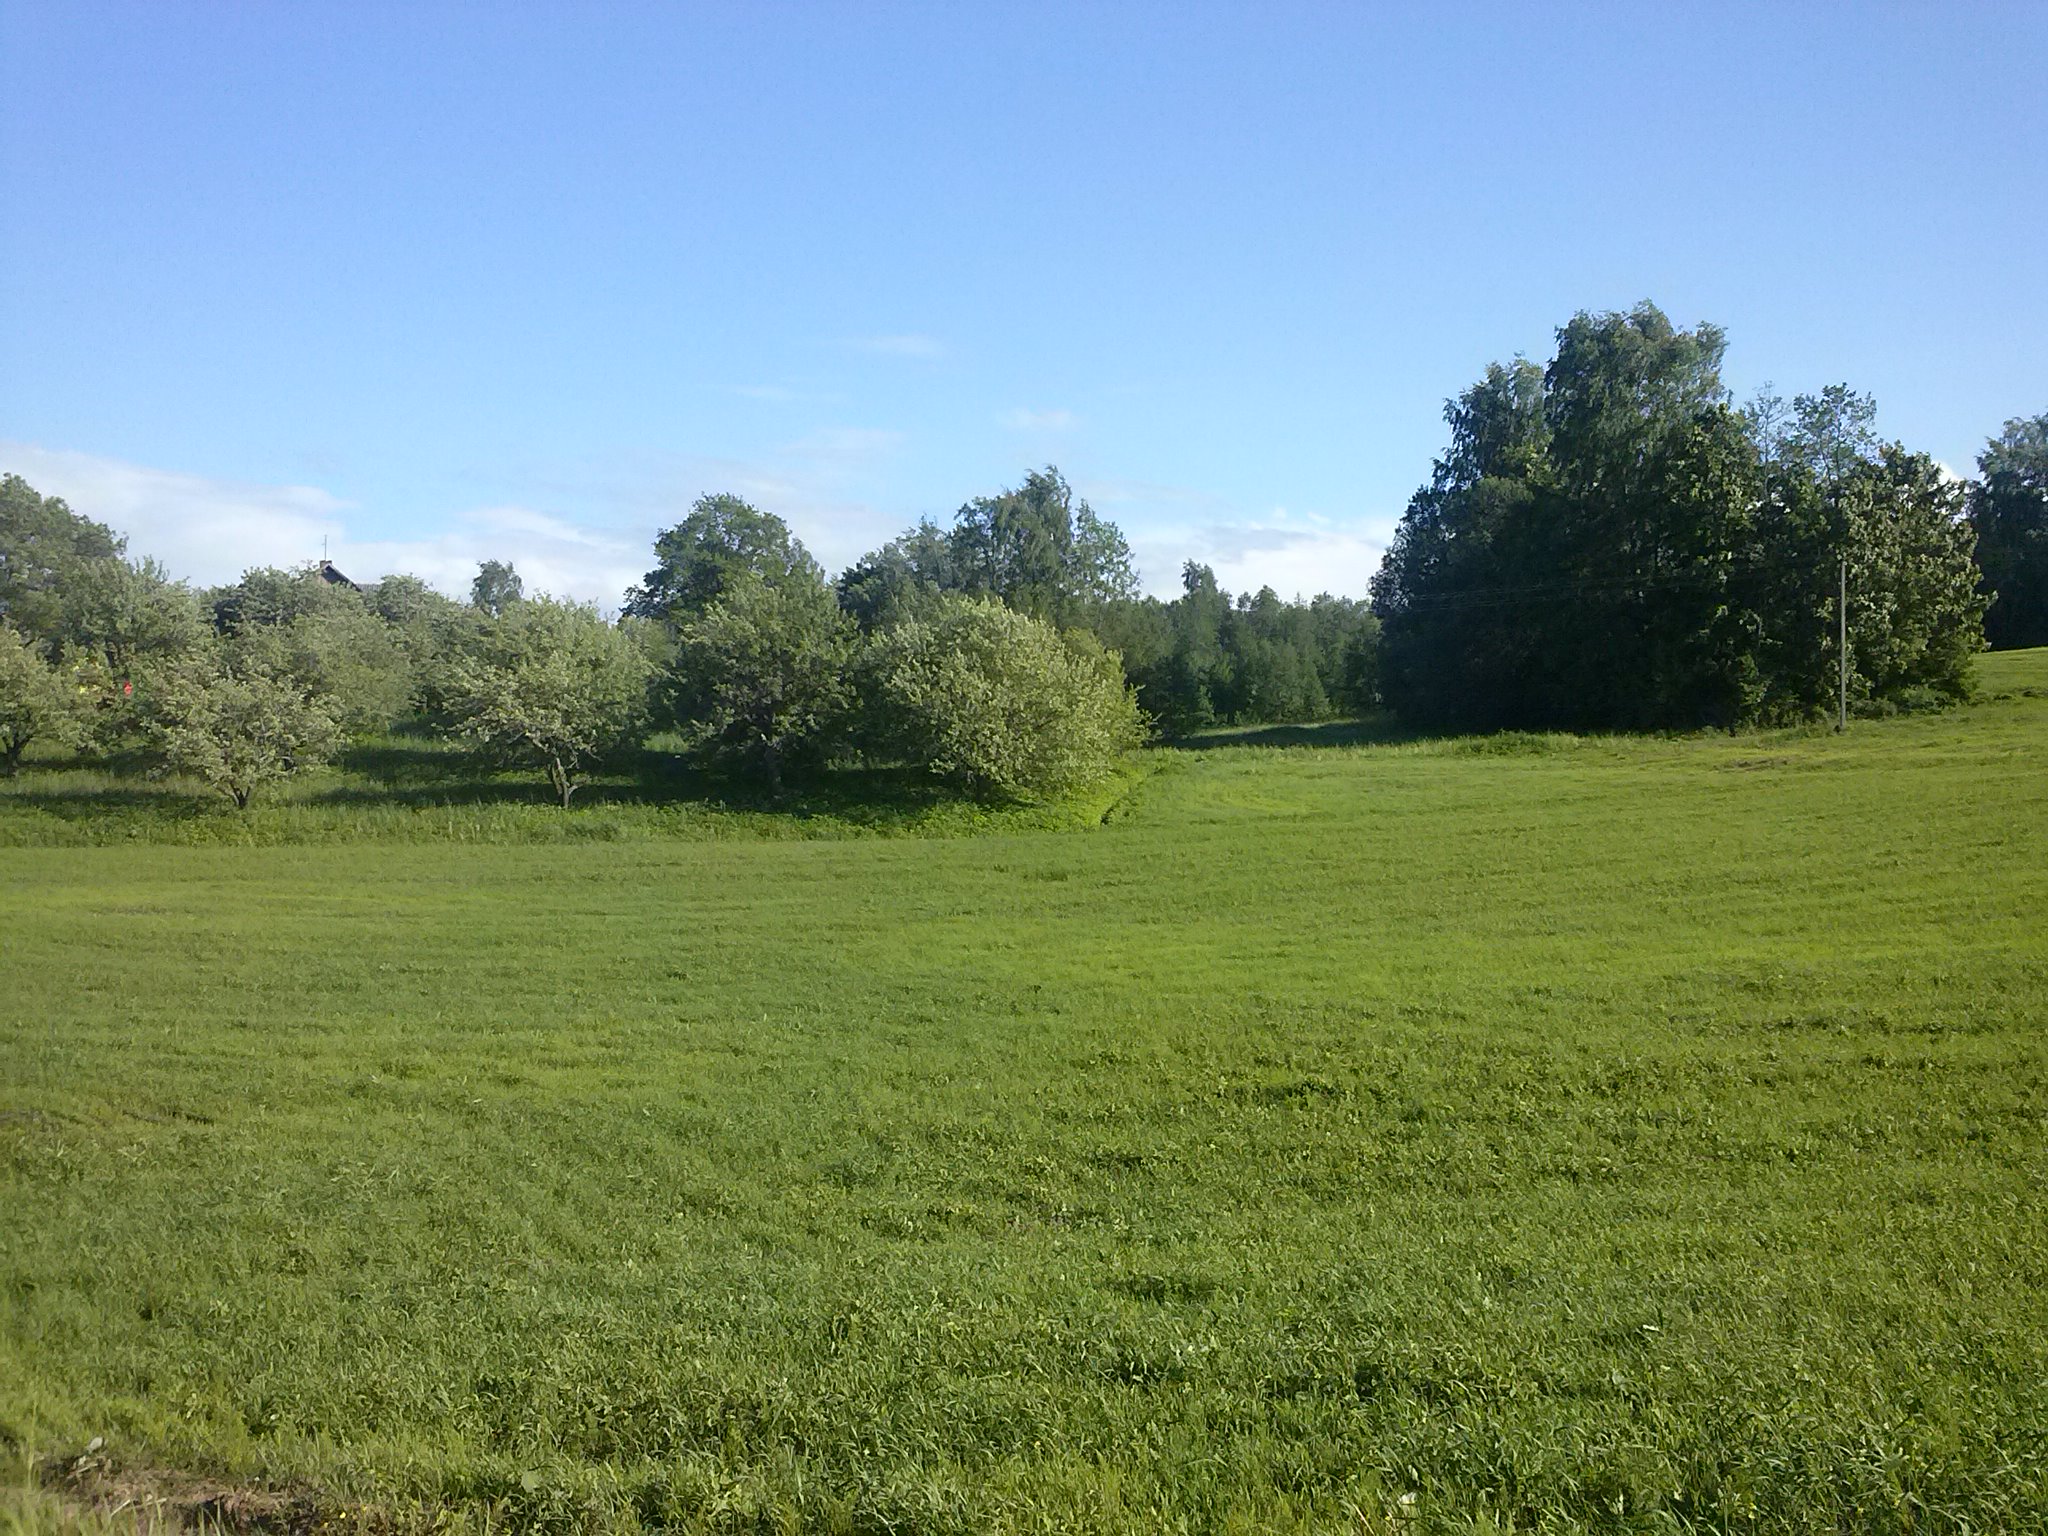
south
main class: Cropland
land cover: Apple fruit
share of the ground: > 75 %
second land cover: Grassland without tree/shrub cover
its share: > 75 %
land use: Kitchen garden
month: June
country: LV
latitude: 56.3486
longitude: 27.6775
